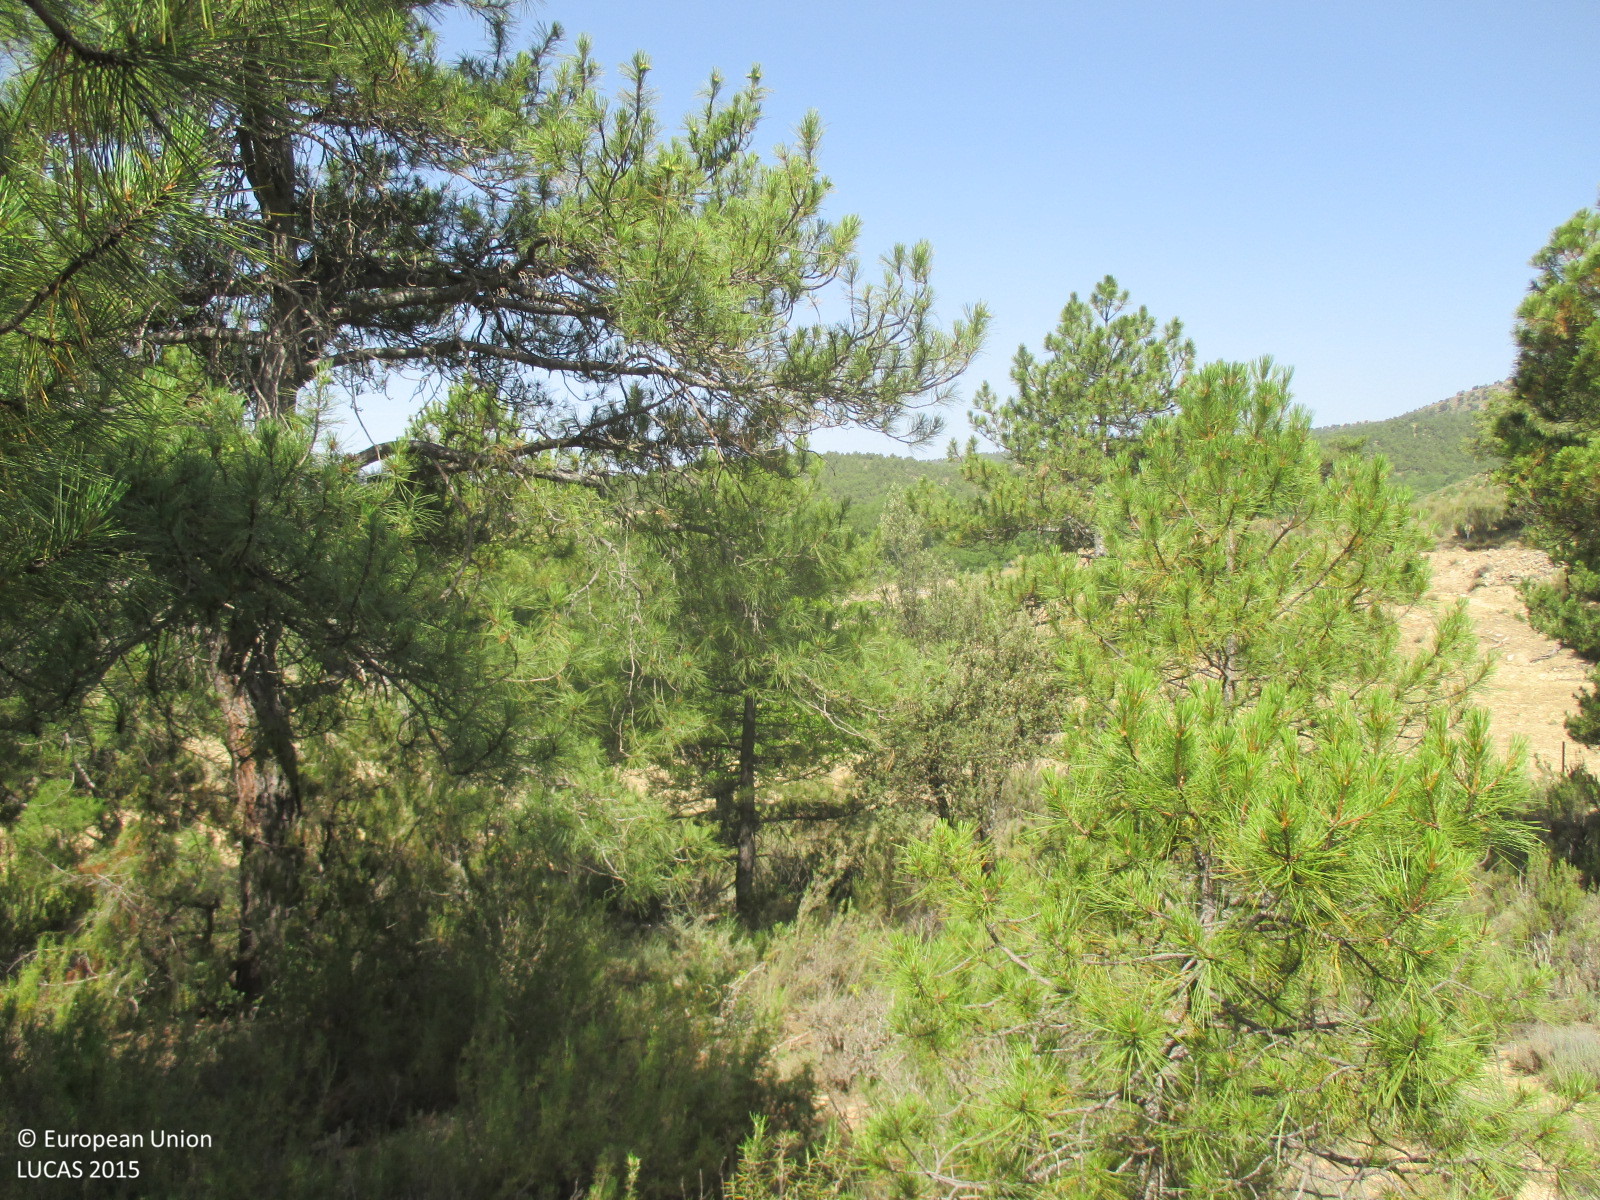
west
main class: Woodland
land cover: Pine dominated coniferous woodland
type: coniferous forest of the mediterranean region
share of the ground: 50 - 75 %
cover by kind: coniferous forest trees 60 %, shrubs 20 %, herbaceous plants 20 %
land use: Forestry
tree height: > 5 m
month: July
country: ES
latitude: 37.9874
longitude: -2.4595
